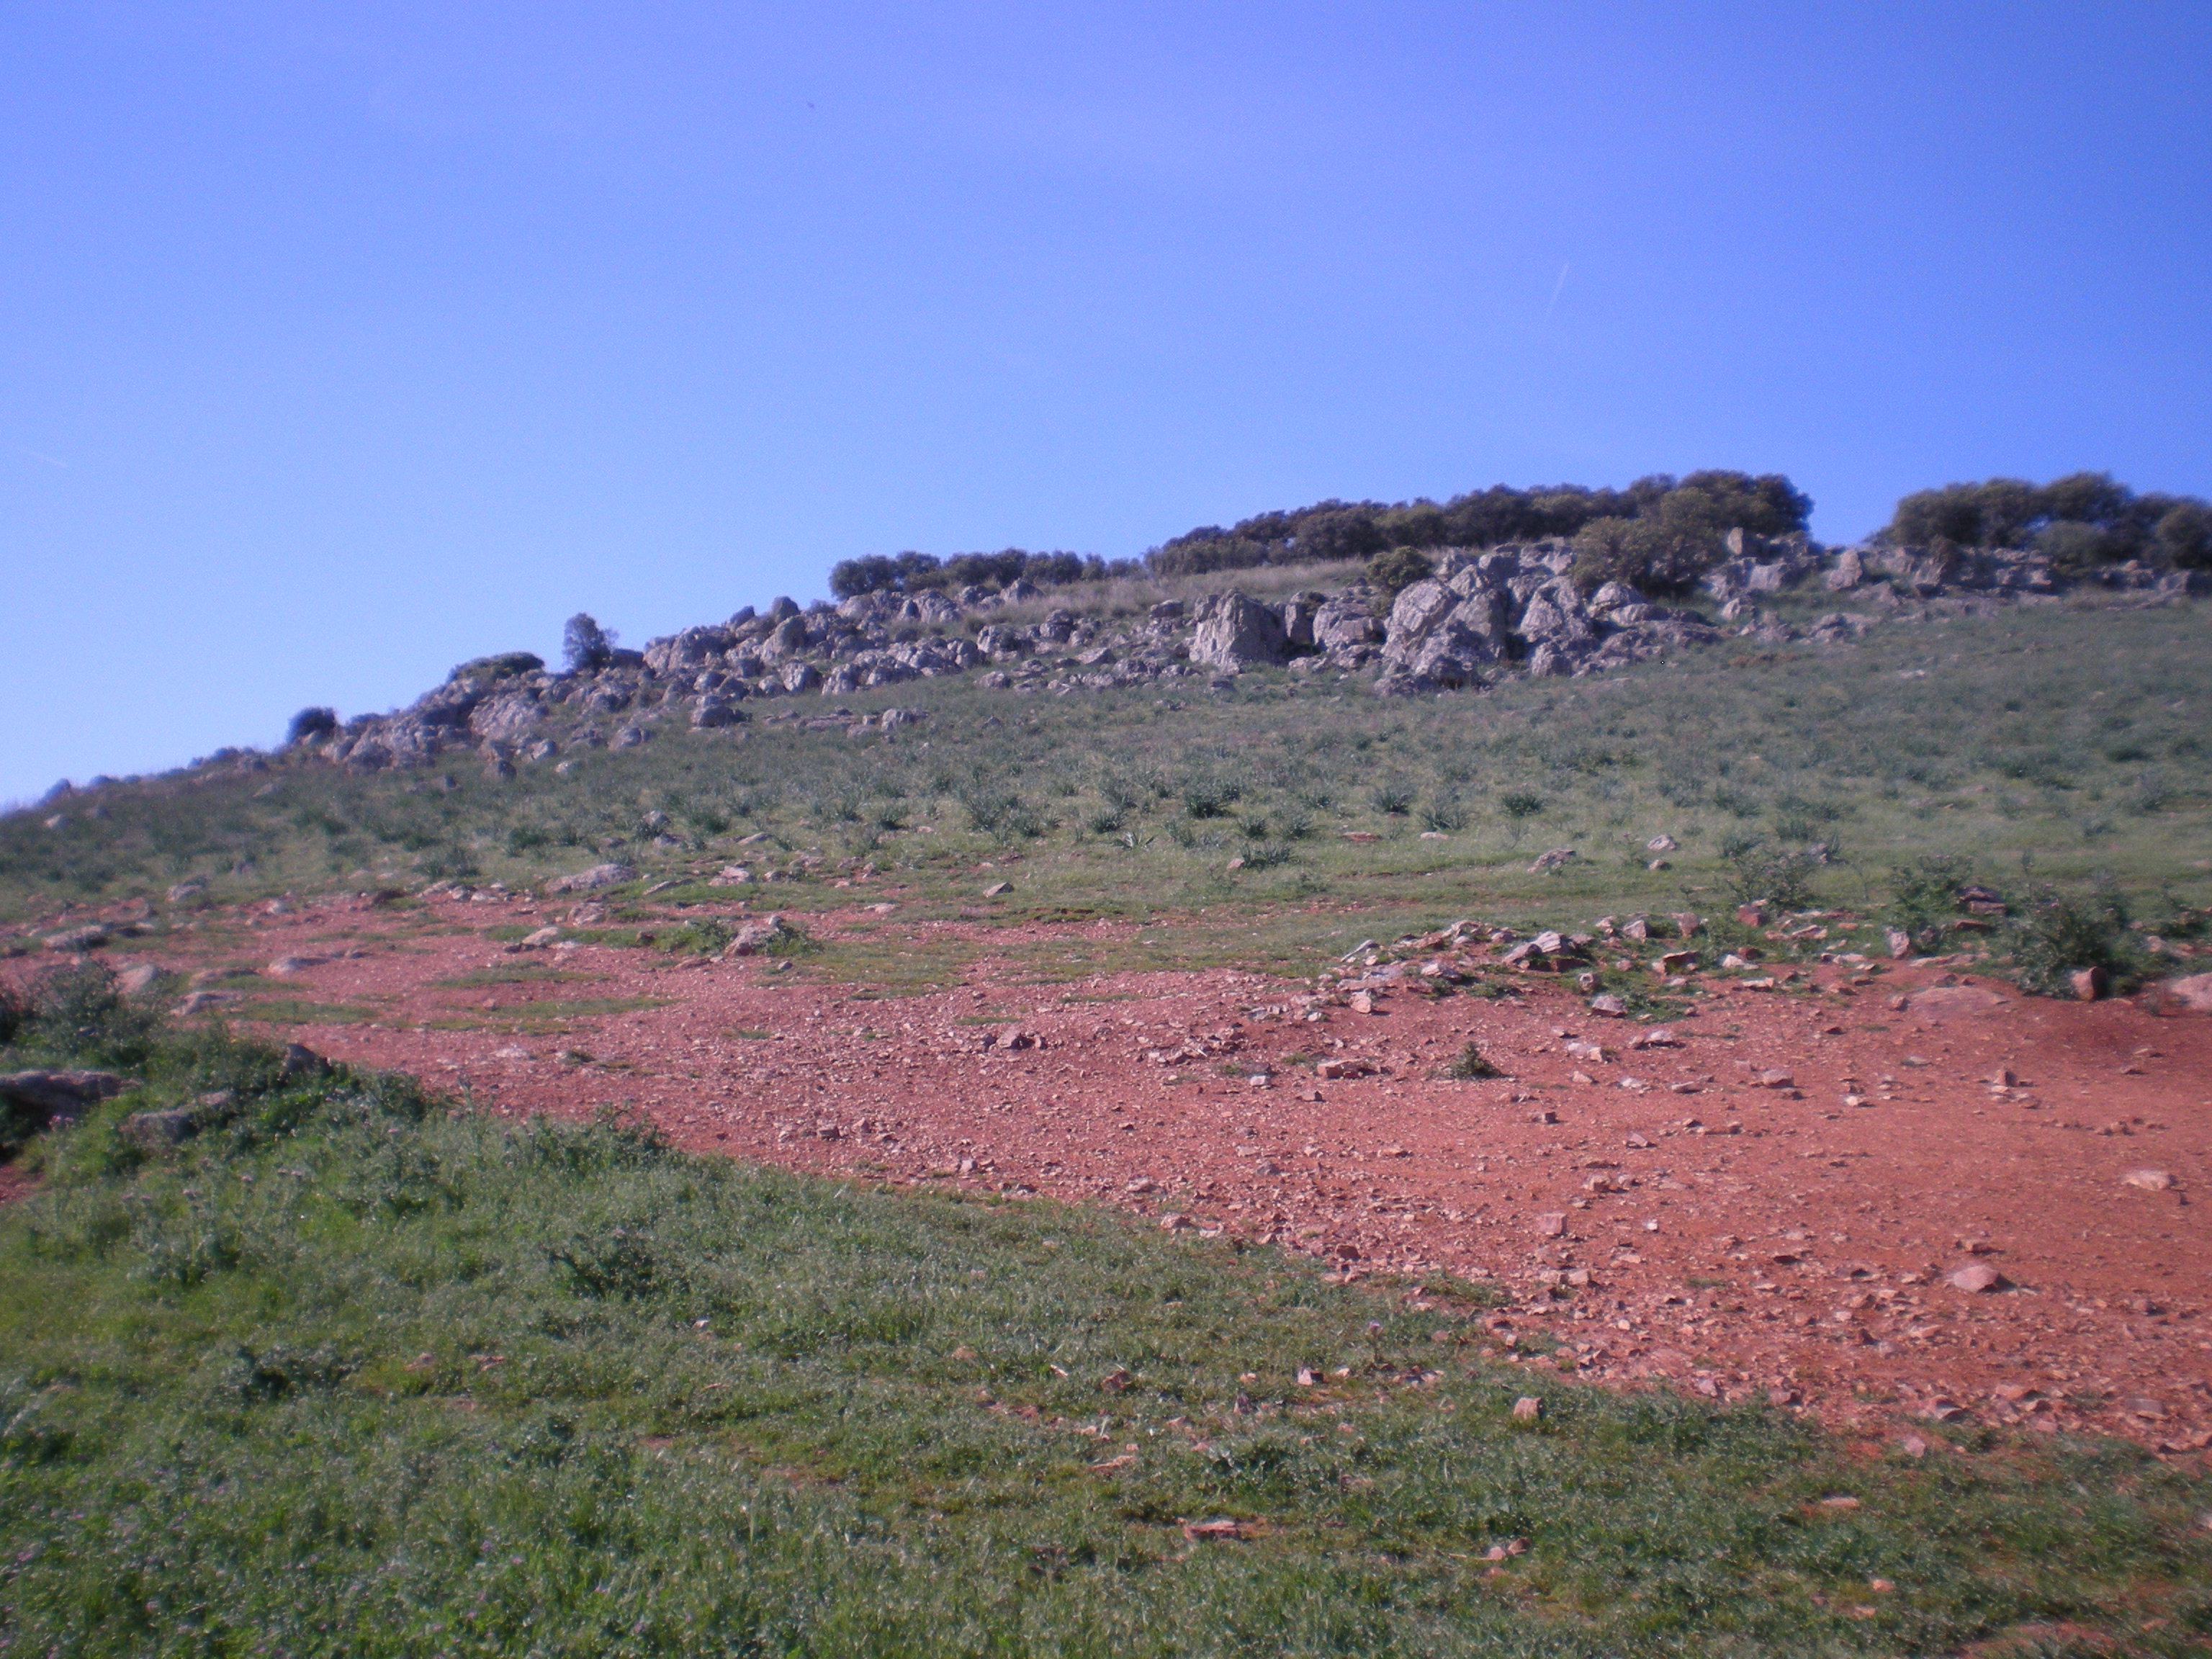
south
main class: Grassland
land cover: Grassland without tree/shrub cover
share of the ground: > 75 %
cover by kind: herbaceous plants 80 %, unconsolidated bare surface 20 %
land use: Agriculture (excluding fallow land and kitchen gardens)
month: April
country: ES
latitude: 38.9170
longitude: -3.5668
